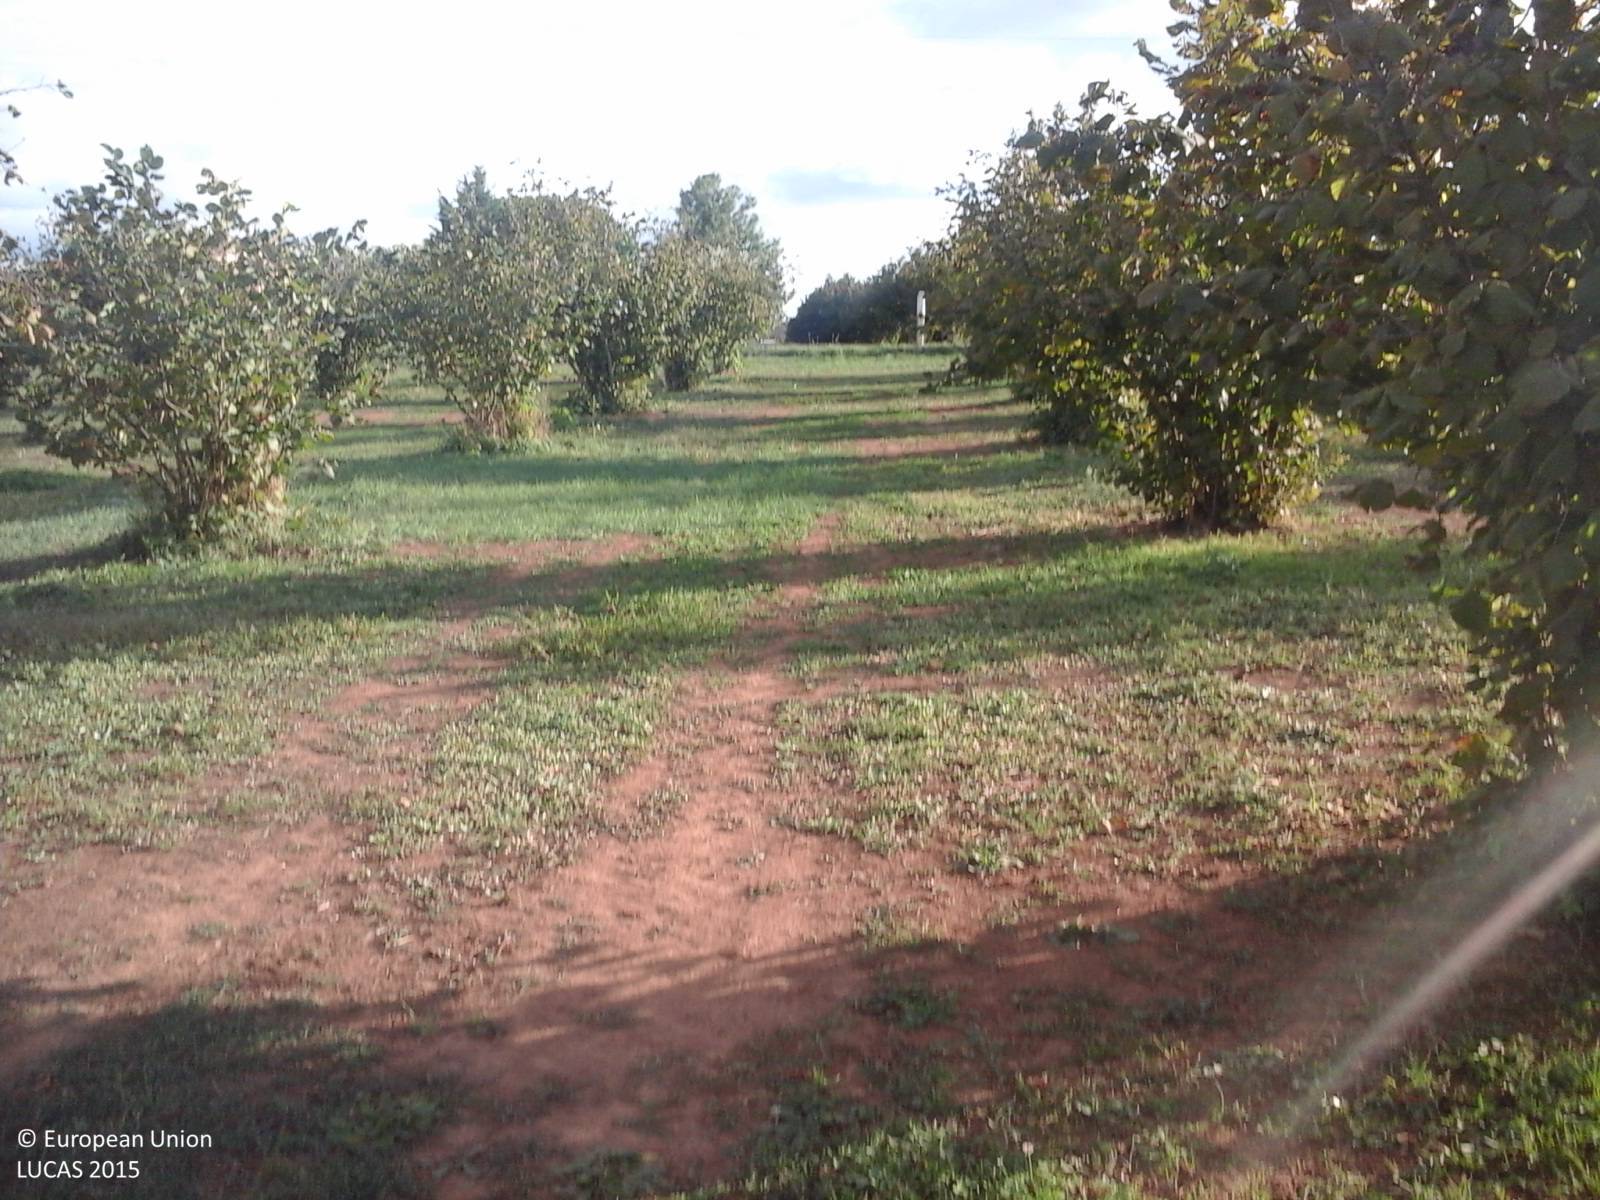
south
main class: Cropland
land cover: Nuts trees
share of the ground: > 75 %
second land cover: Spontaneously vegetated surfaces
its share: > 75 %
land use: Agriculture (excluding fallow land and kitchen gardens)
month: September
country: IT
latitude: 42.4102
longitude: 12.3373
